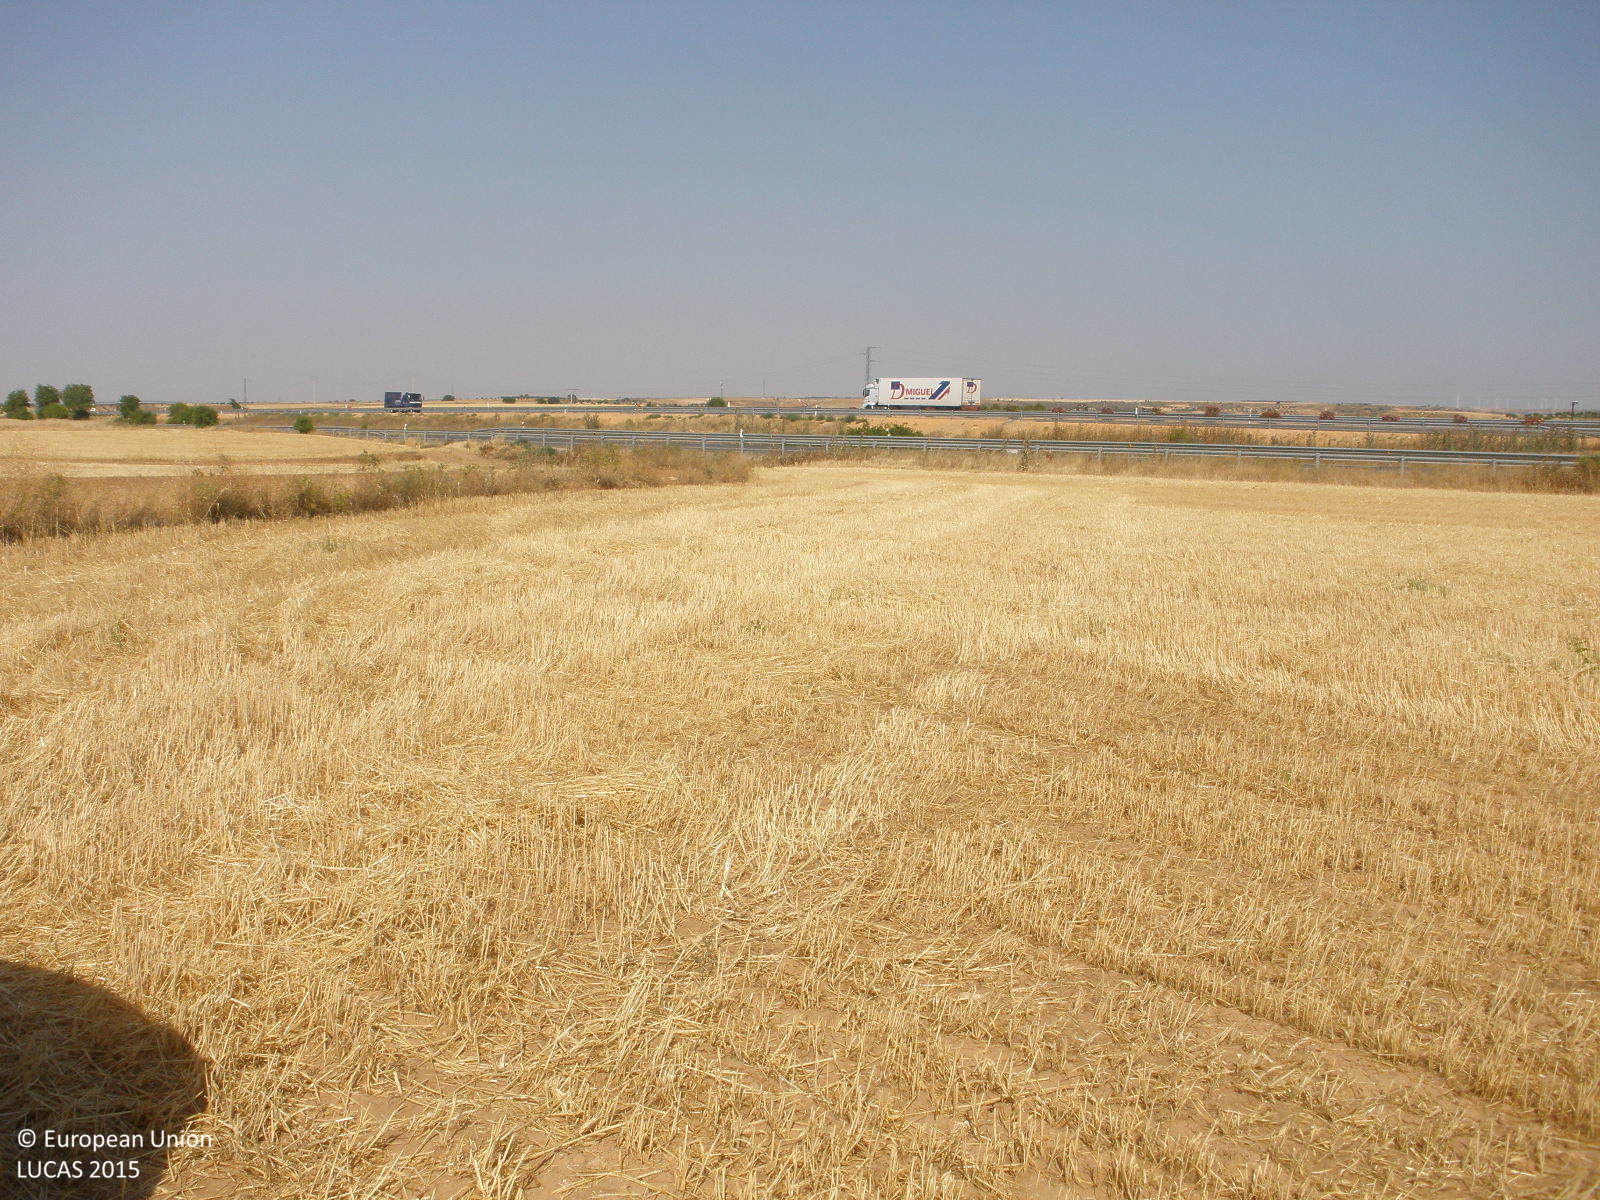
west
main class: Cropland
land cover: Common wheat
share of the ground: < 10 %
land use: Agriculture (excluding fallow land and kitchen gardens)
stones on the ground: < 10 %
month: July
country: ES
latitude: 39.9514
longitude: -3.2406
